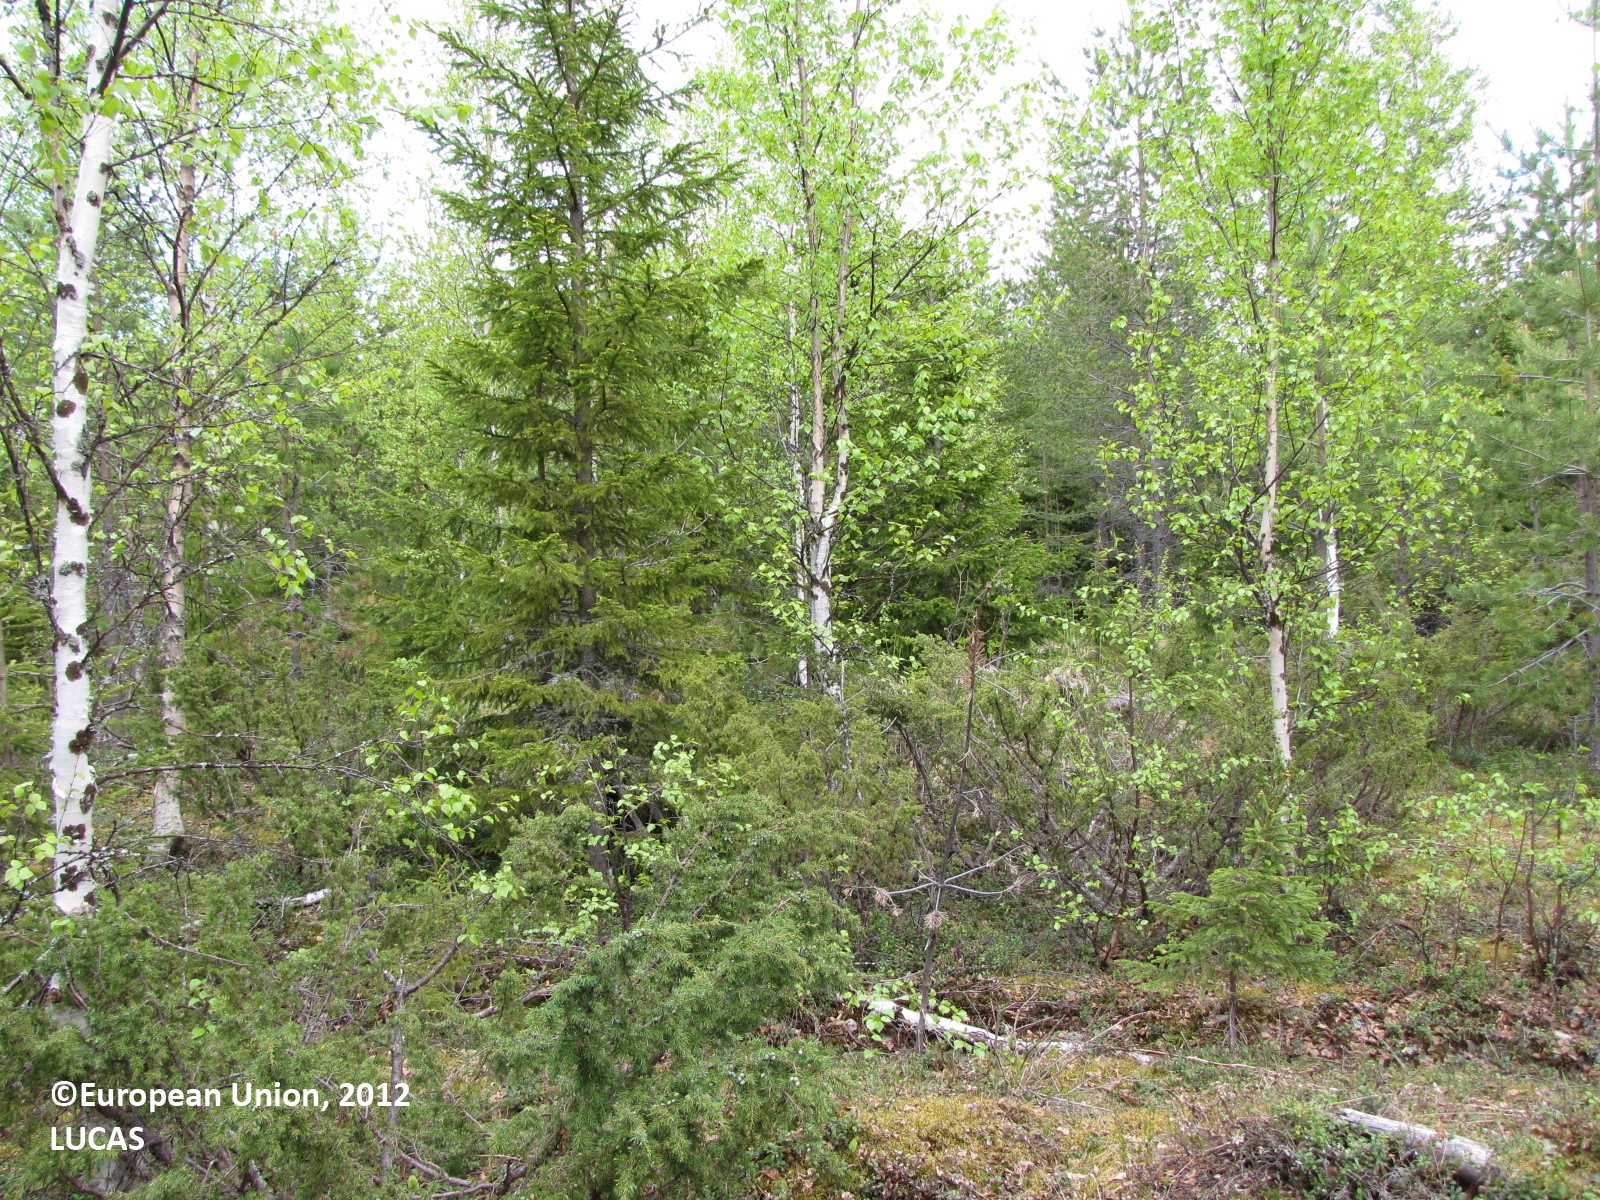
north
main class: Woodland
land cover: Other coniferous woodland
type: boreal forest
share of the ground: 25 - 50 %
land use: Forestry
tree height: > 5 m
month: June
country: FI
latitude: 65.8525
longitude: 24.6680
